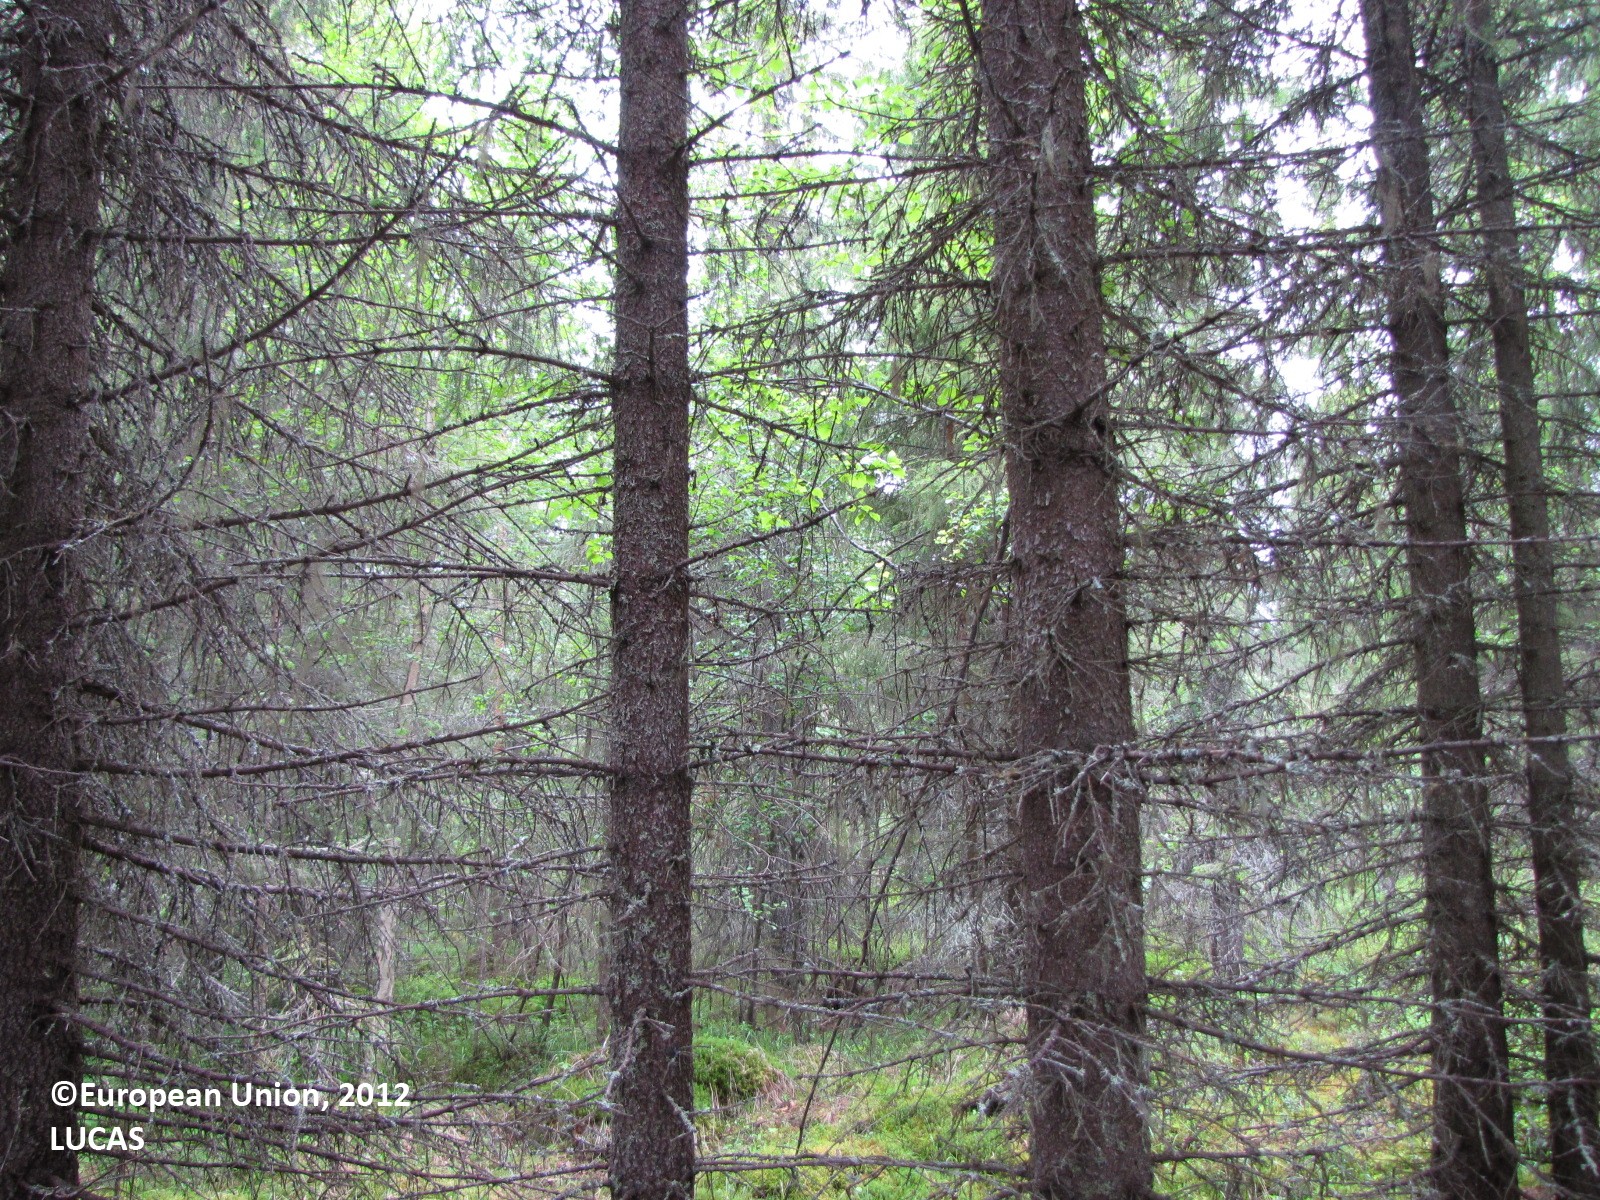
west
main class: Woodland
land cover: Spruce dominated mixed woodland
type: boreal forest
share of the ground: 50 - 75 %
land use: Forestry
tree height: > 5 m
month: July
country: FI
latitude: 66.5753
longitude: 24.8603
